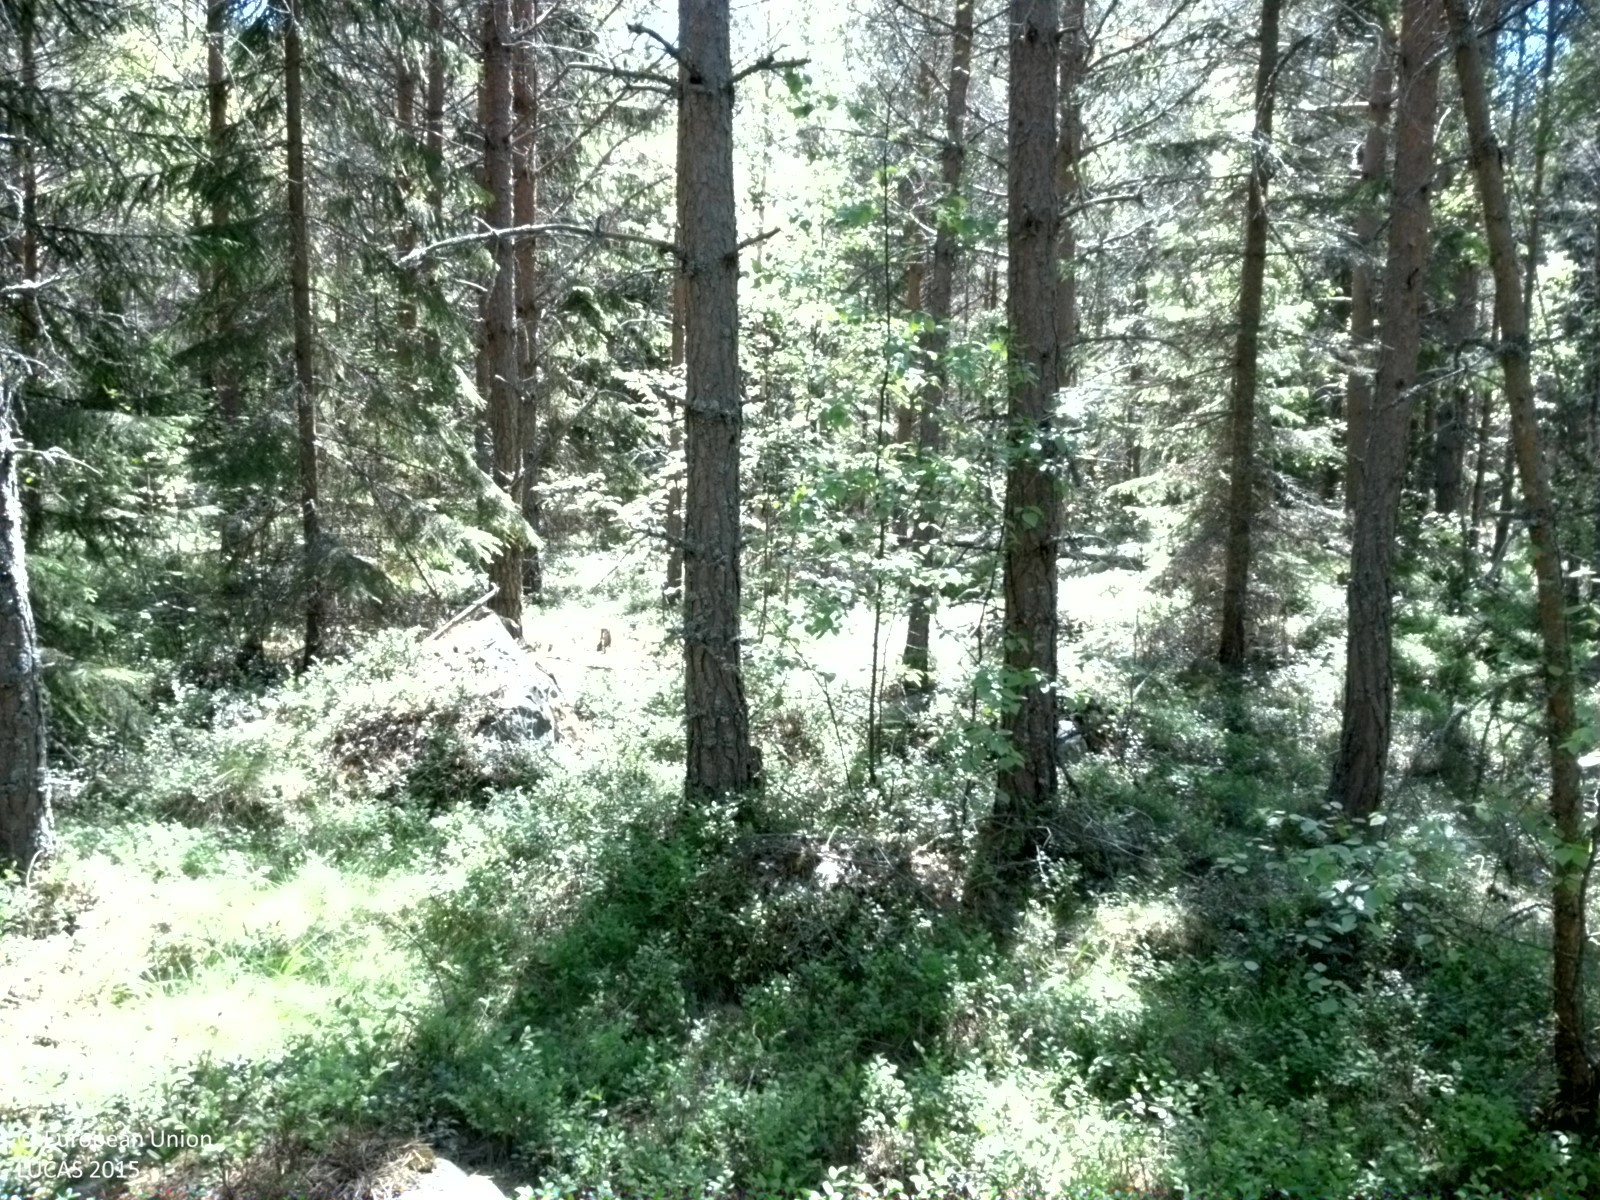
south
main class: Woodland
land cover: Pine dominated coniferous woodland
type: boreal forest
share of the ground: > 75 %
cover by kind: coniferous forest trees 70 %, broadleaved forest trees 10 %, shrubs 10 %, herbaceous plants 5 %, consolidated bare surface 5 %
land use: Forestry
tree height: > 5 m
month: June
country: SE
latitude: 60.2095
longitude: 17.6255
